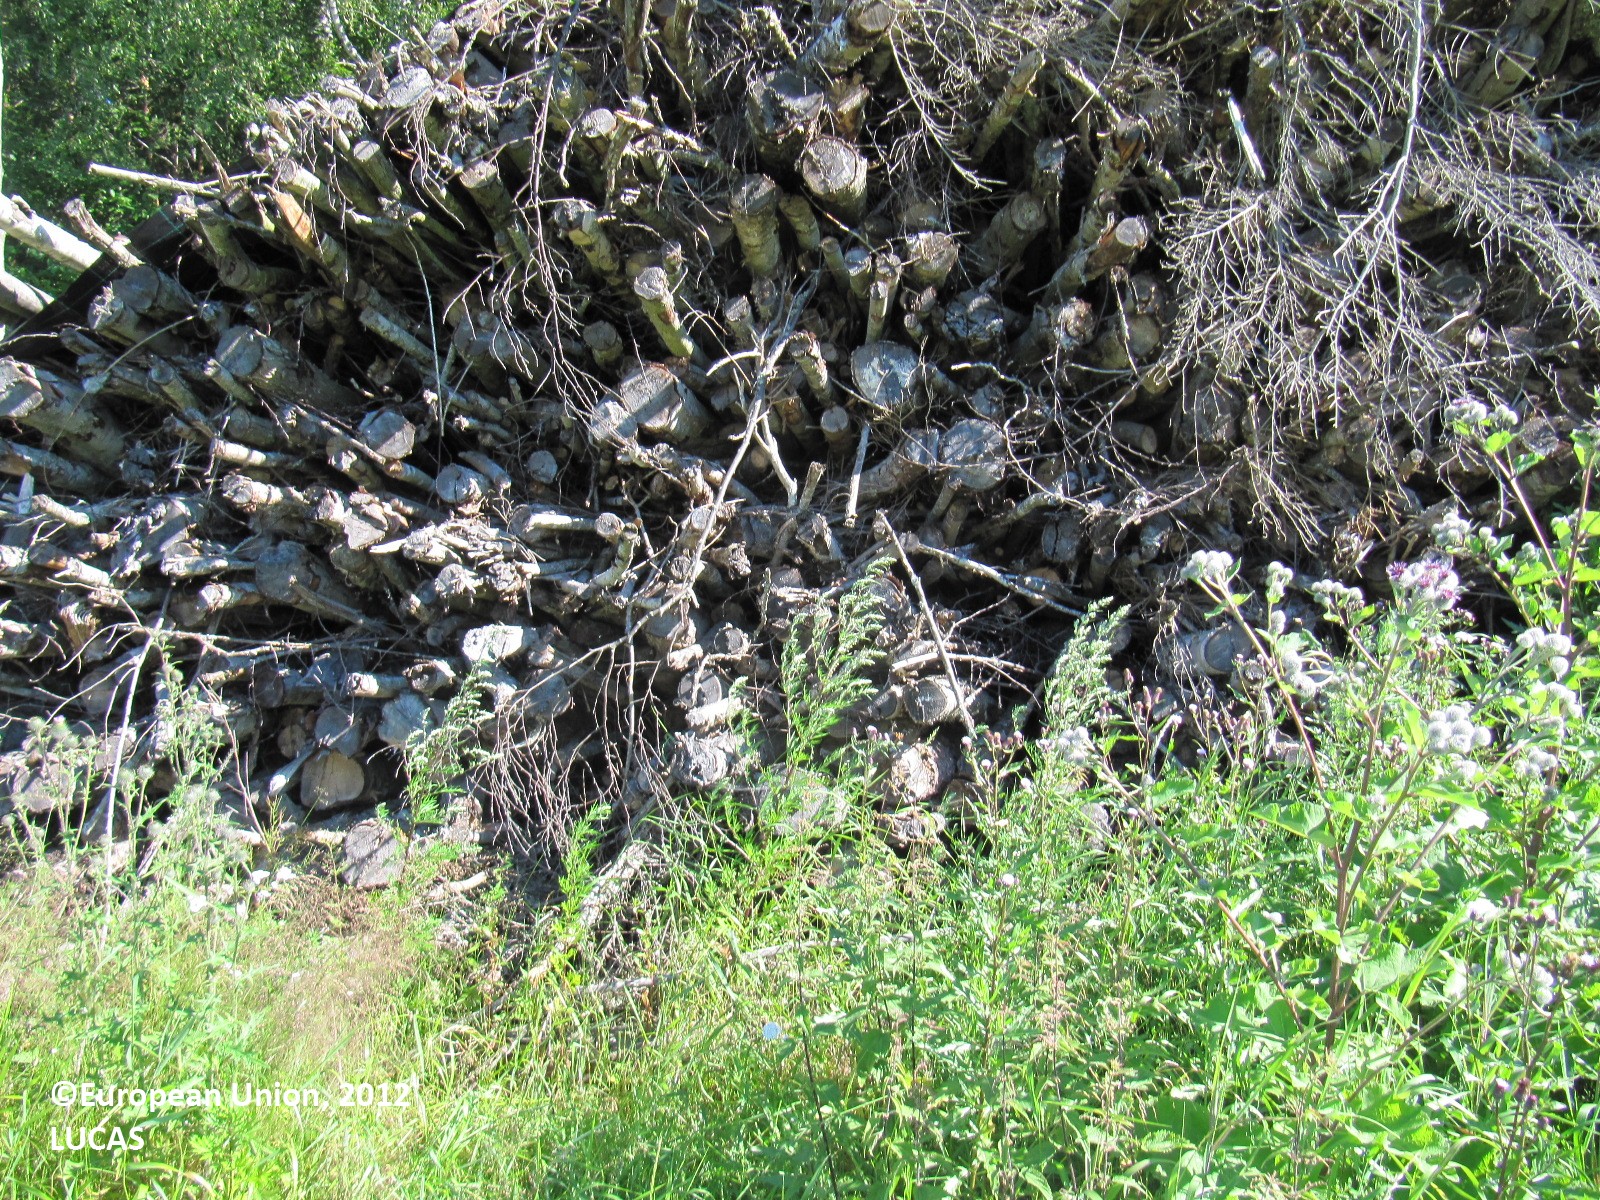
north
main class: Cropland
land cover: Barley
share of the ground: > 75 %
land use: Agriculture (excluding fallow land and kitchen gardens)
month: July
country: FI
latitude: 60.8558
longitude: 24.5171
